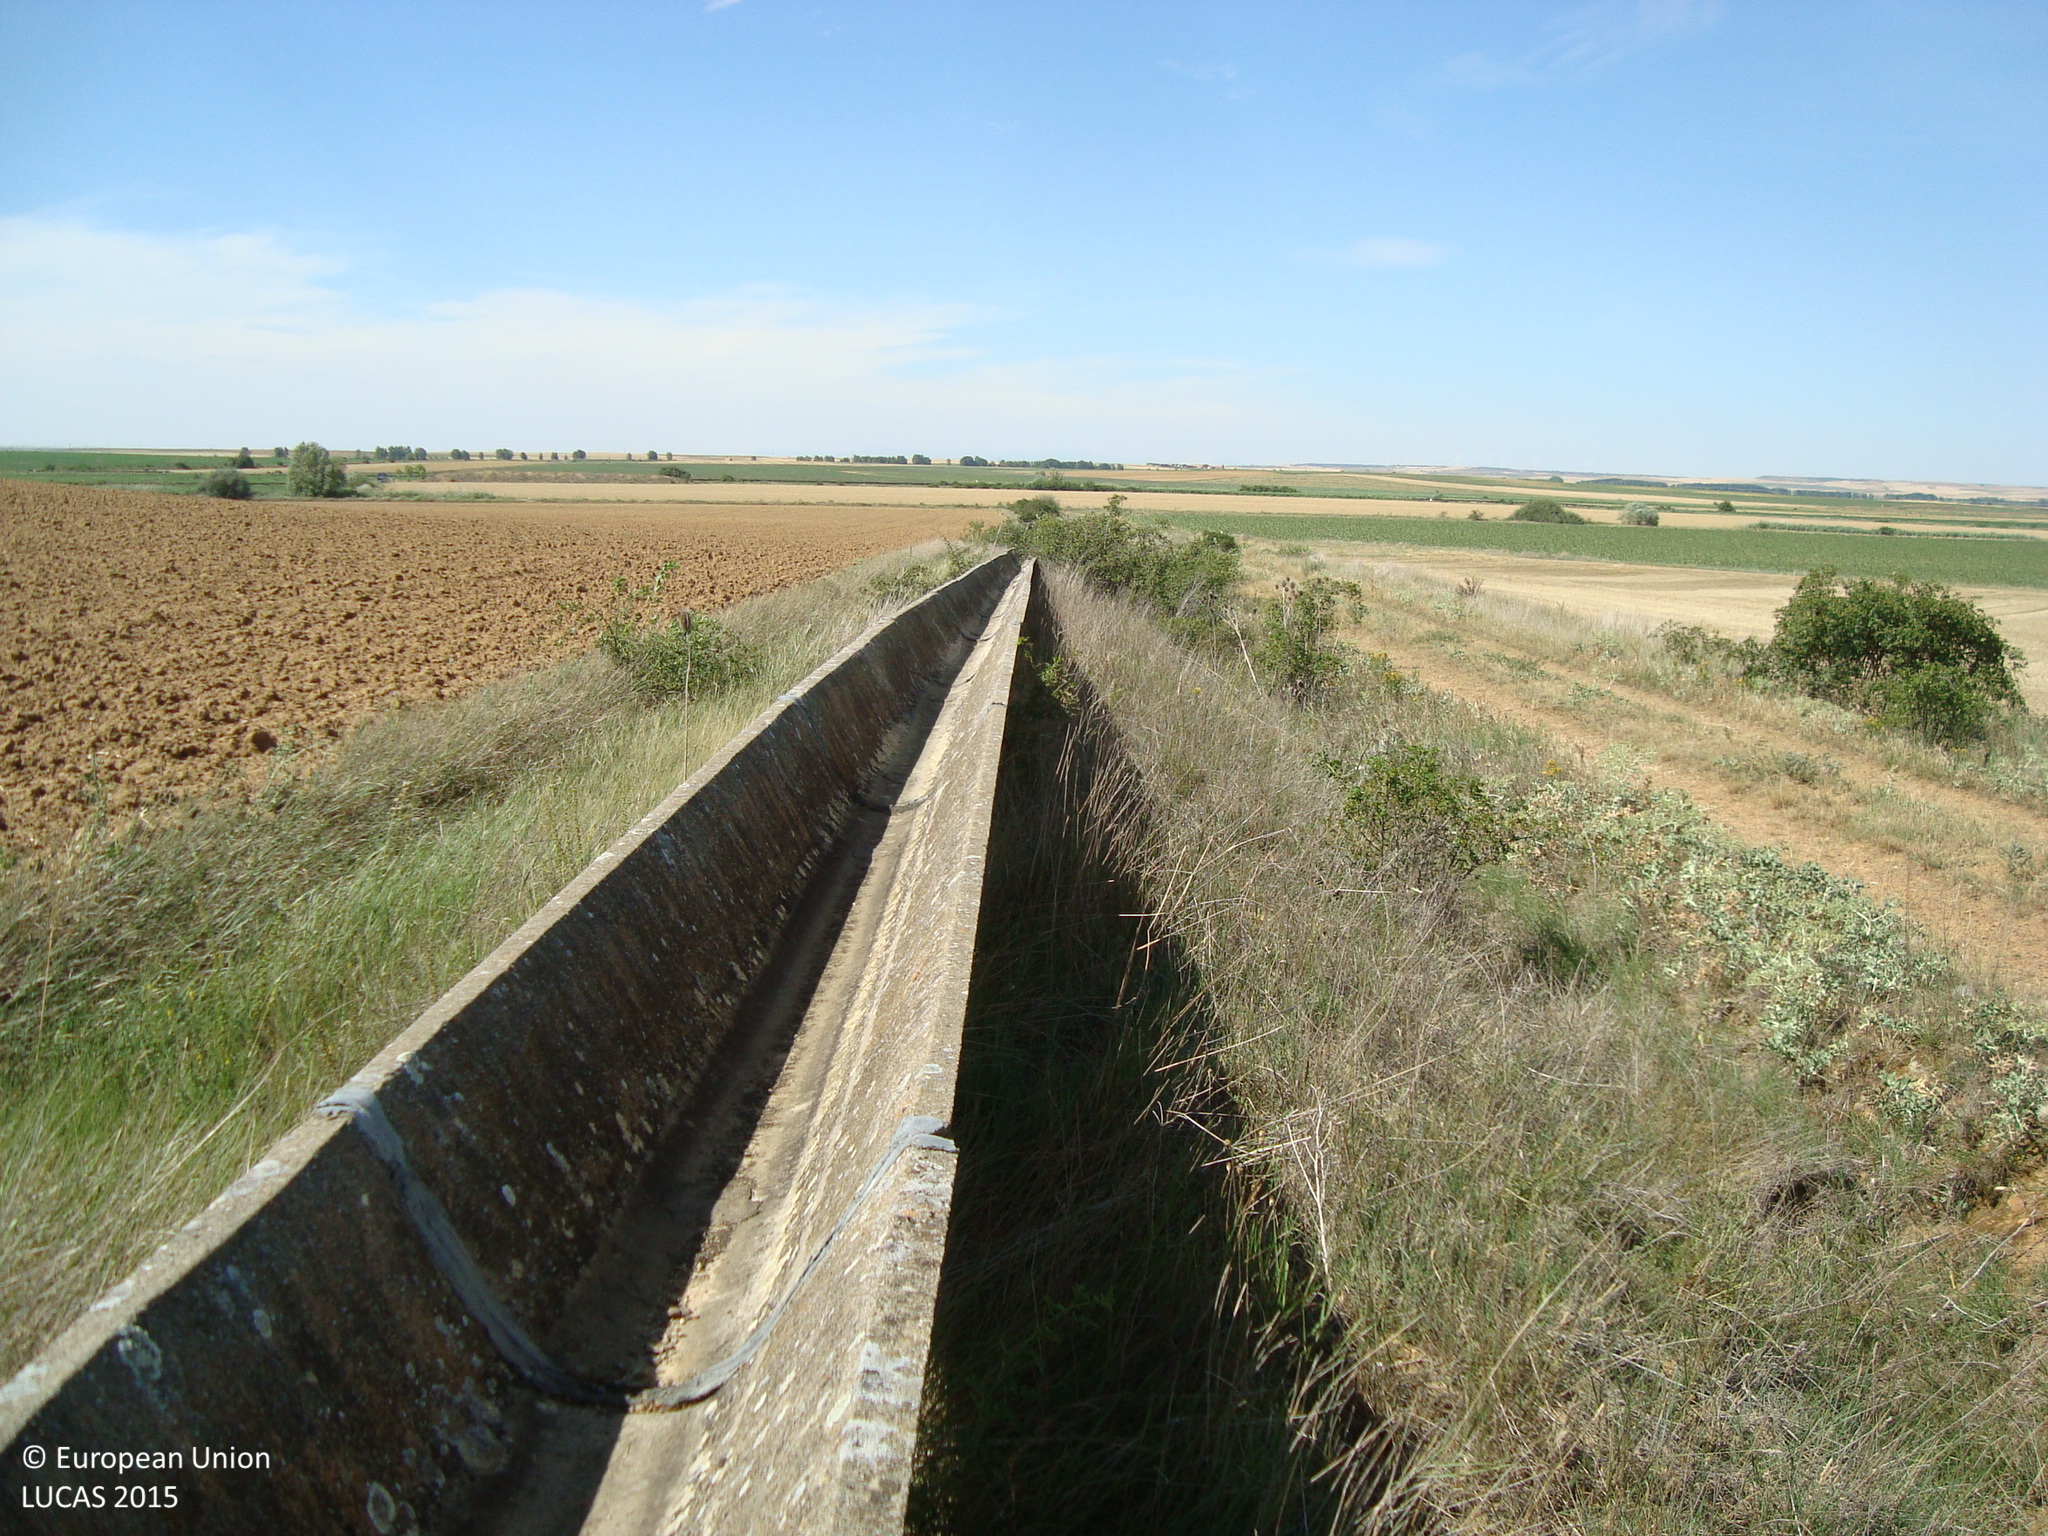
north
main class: Cropland
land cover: Barley
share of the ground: < 10 %
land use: Agriculture (excluding fallow land and kitchen gardens)
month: July
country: ES
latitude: 42.1142
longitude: -4.7704
